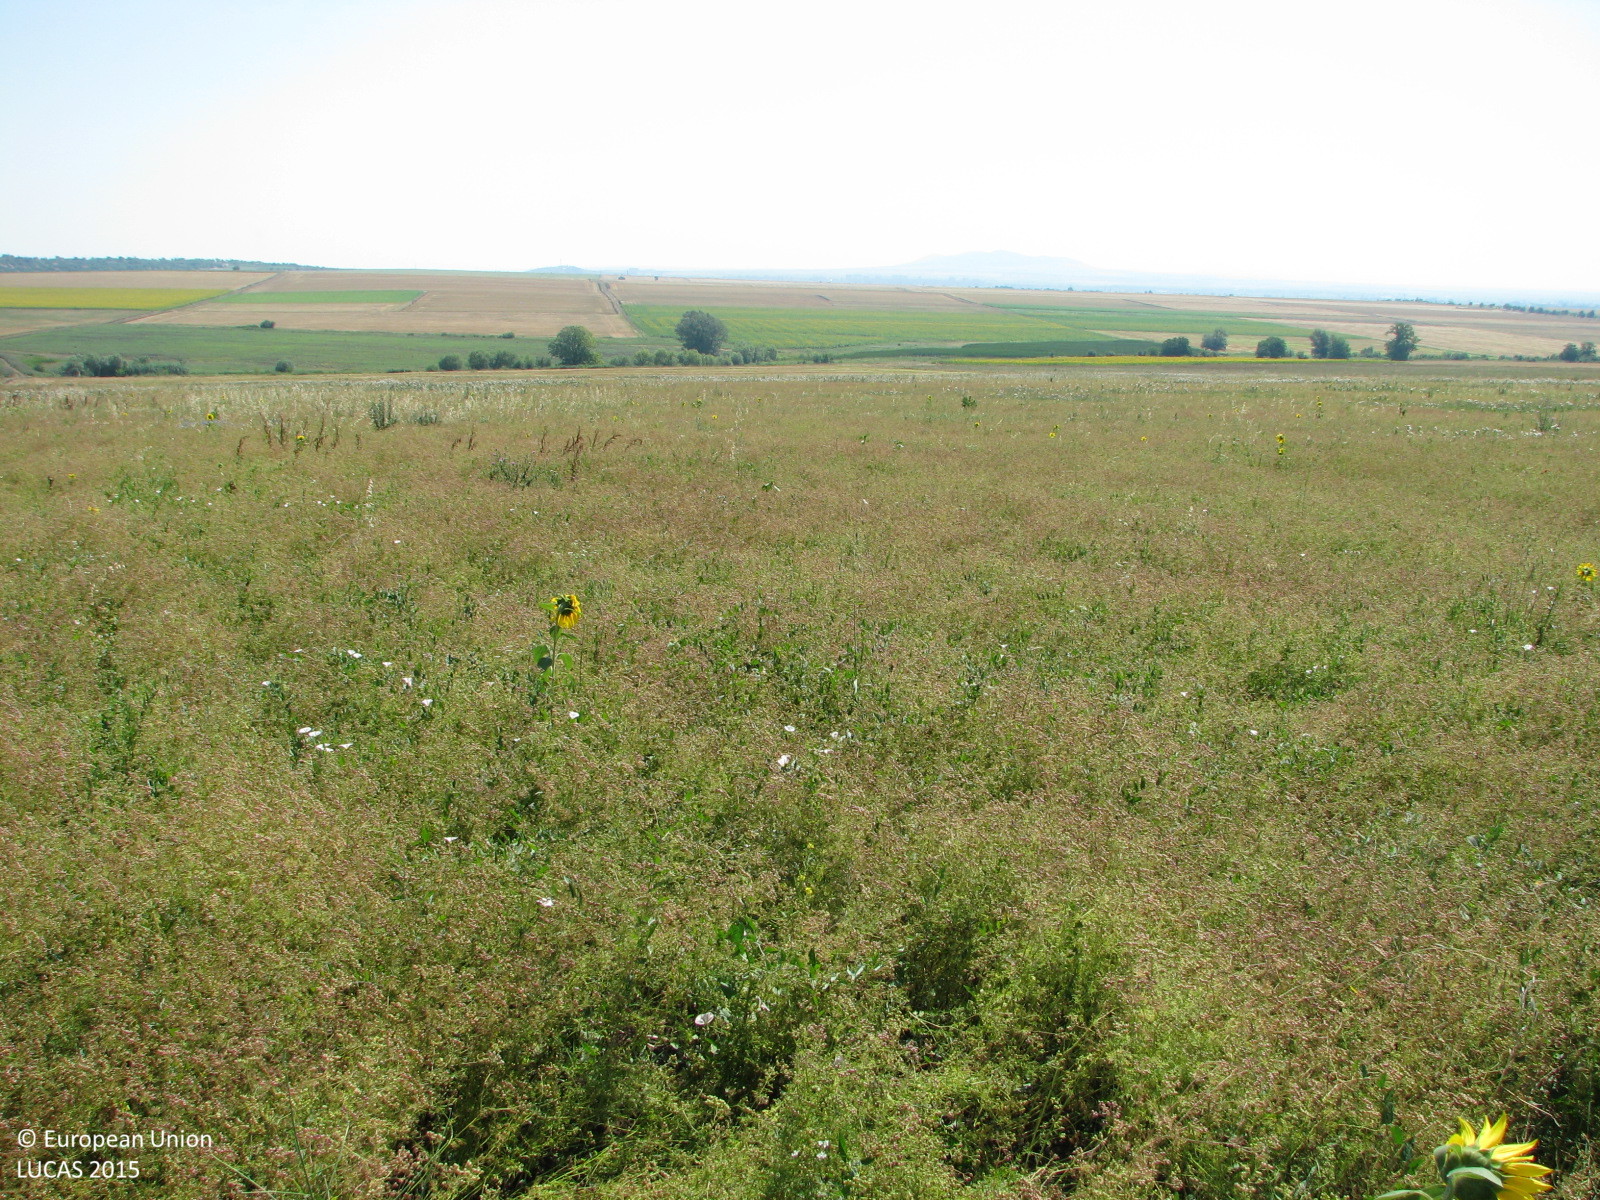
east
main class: Cropland
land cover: Other non-permanent industrial crops
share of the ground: > 75 %
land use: Agriculture (excluding fallow land and kitchen gardens)
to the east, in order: Other non-permanent industrial crops
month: July
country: BG
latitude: 42.4829
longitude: 26.4034
